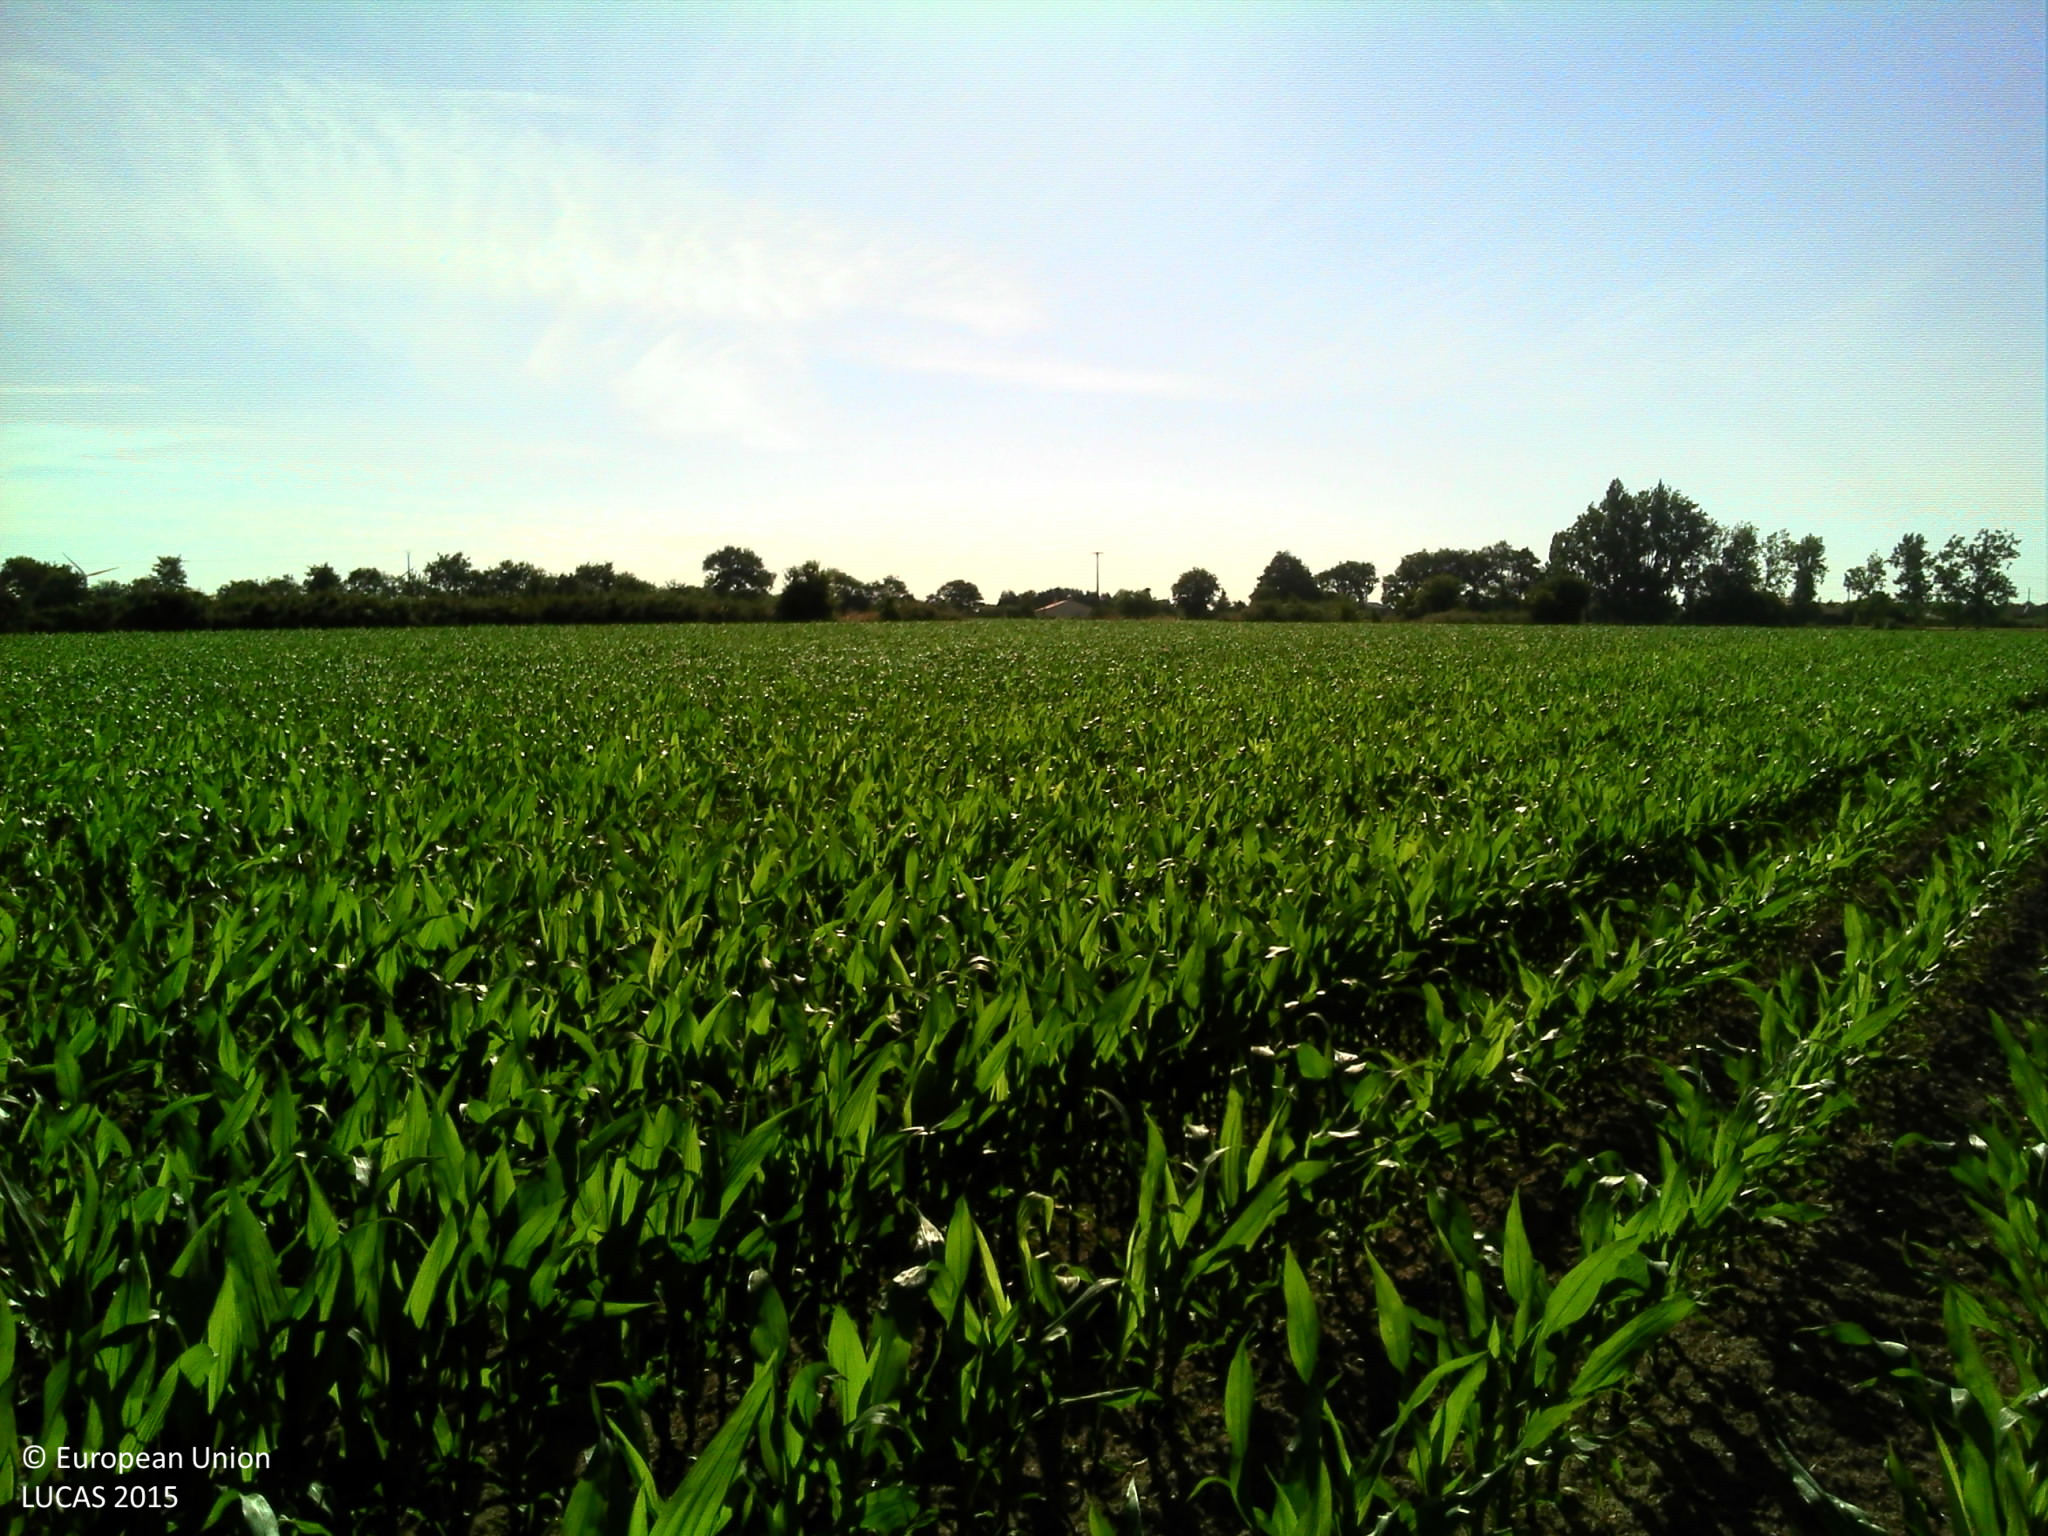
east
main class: Cropland
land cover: Maize
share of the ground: 25 - 50 %
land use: Agriculture (excluding fallow land and kitchen gardens)
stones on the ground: 10 - 25 %
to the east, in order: Maize; Fences; Maize
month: June
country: FR
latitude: 46.9767
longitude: -1.7295
